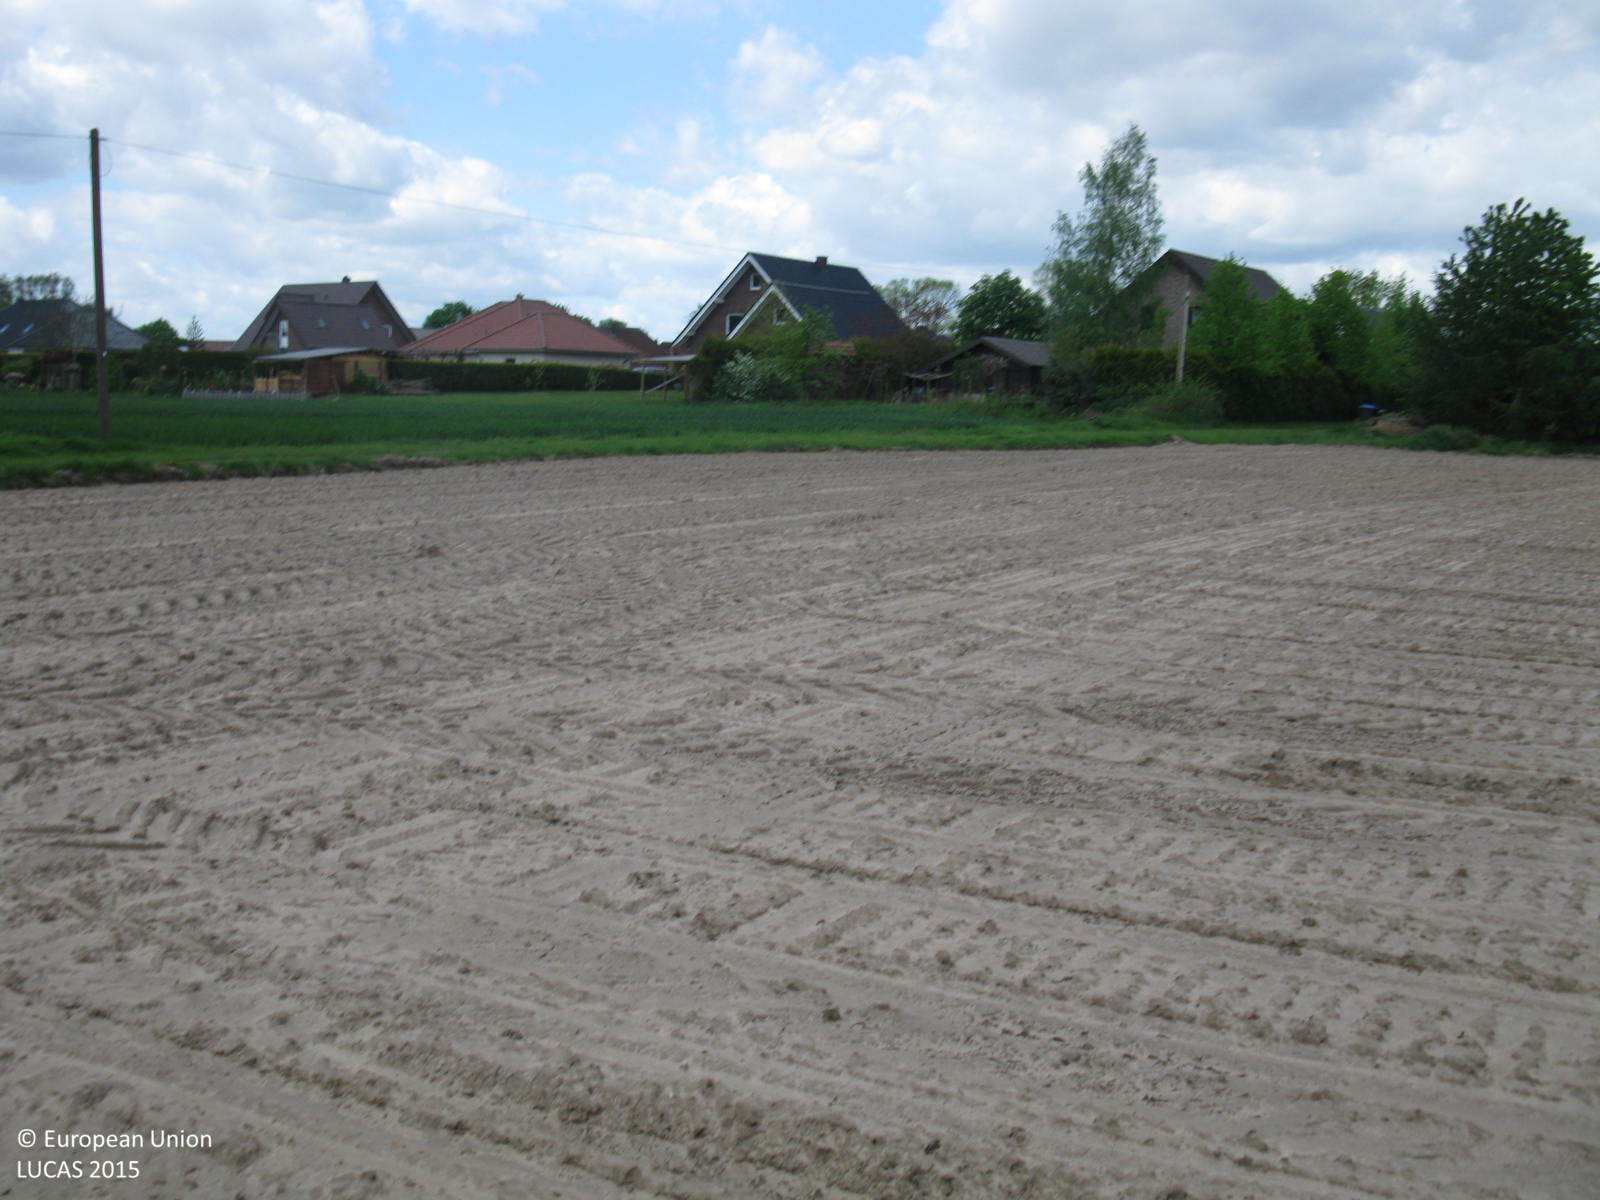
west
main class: Cropland
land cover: Maize
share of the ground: < 10 %
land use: Agriculture (excluding fallow land and kitchen gardens)
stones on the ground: < 10 %
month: May
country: DE
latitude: 52.9225
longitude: 7.3083
